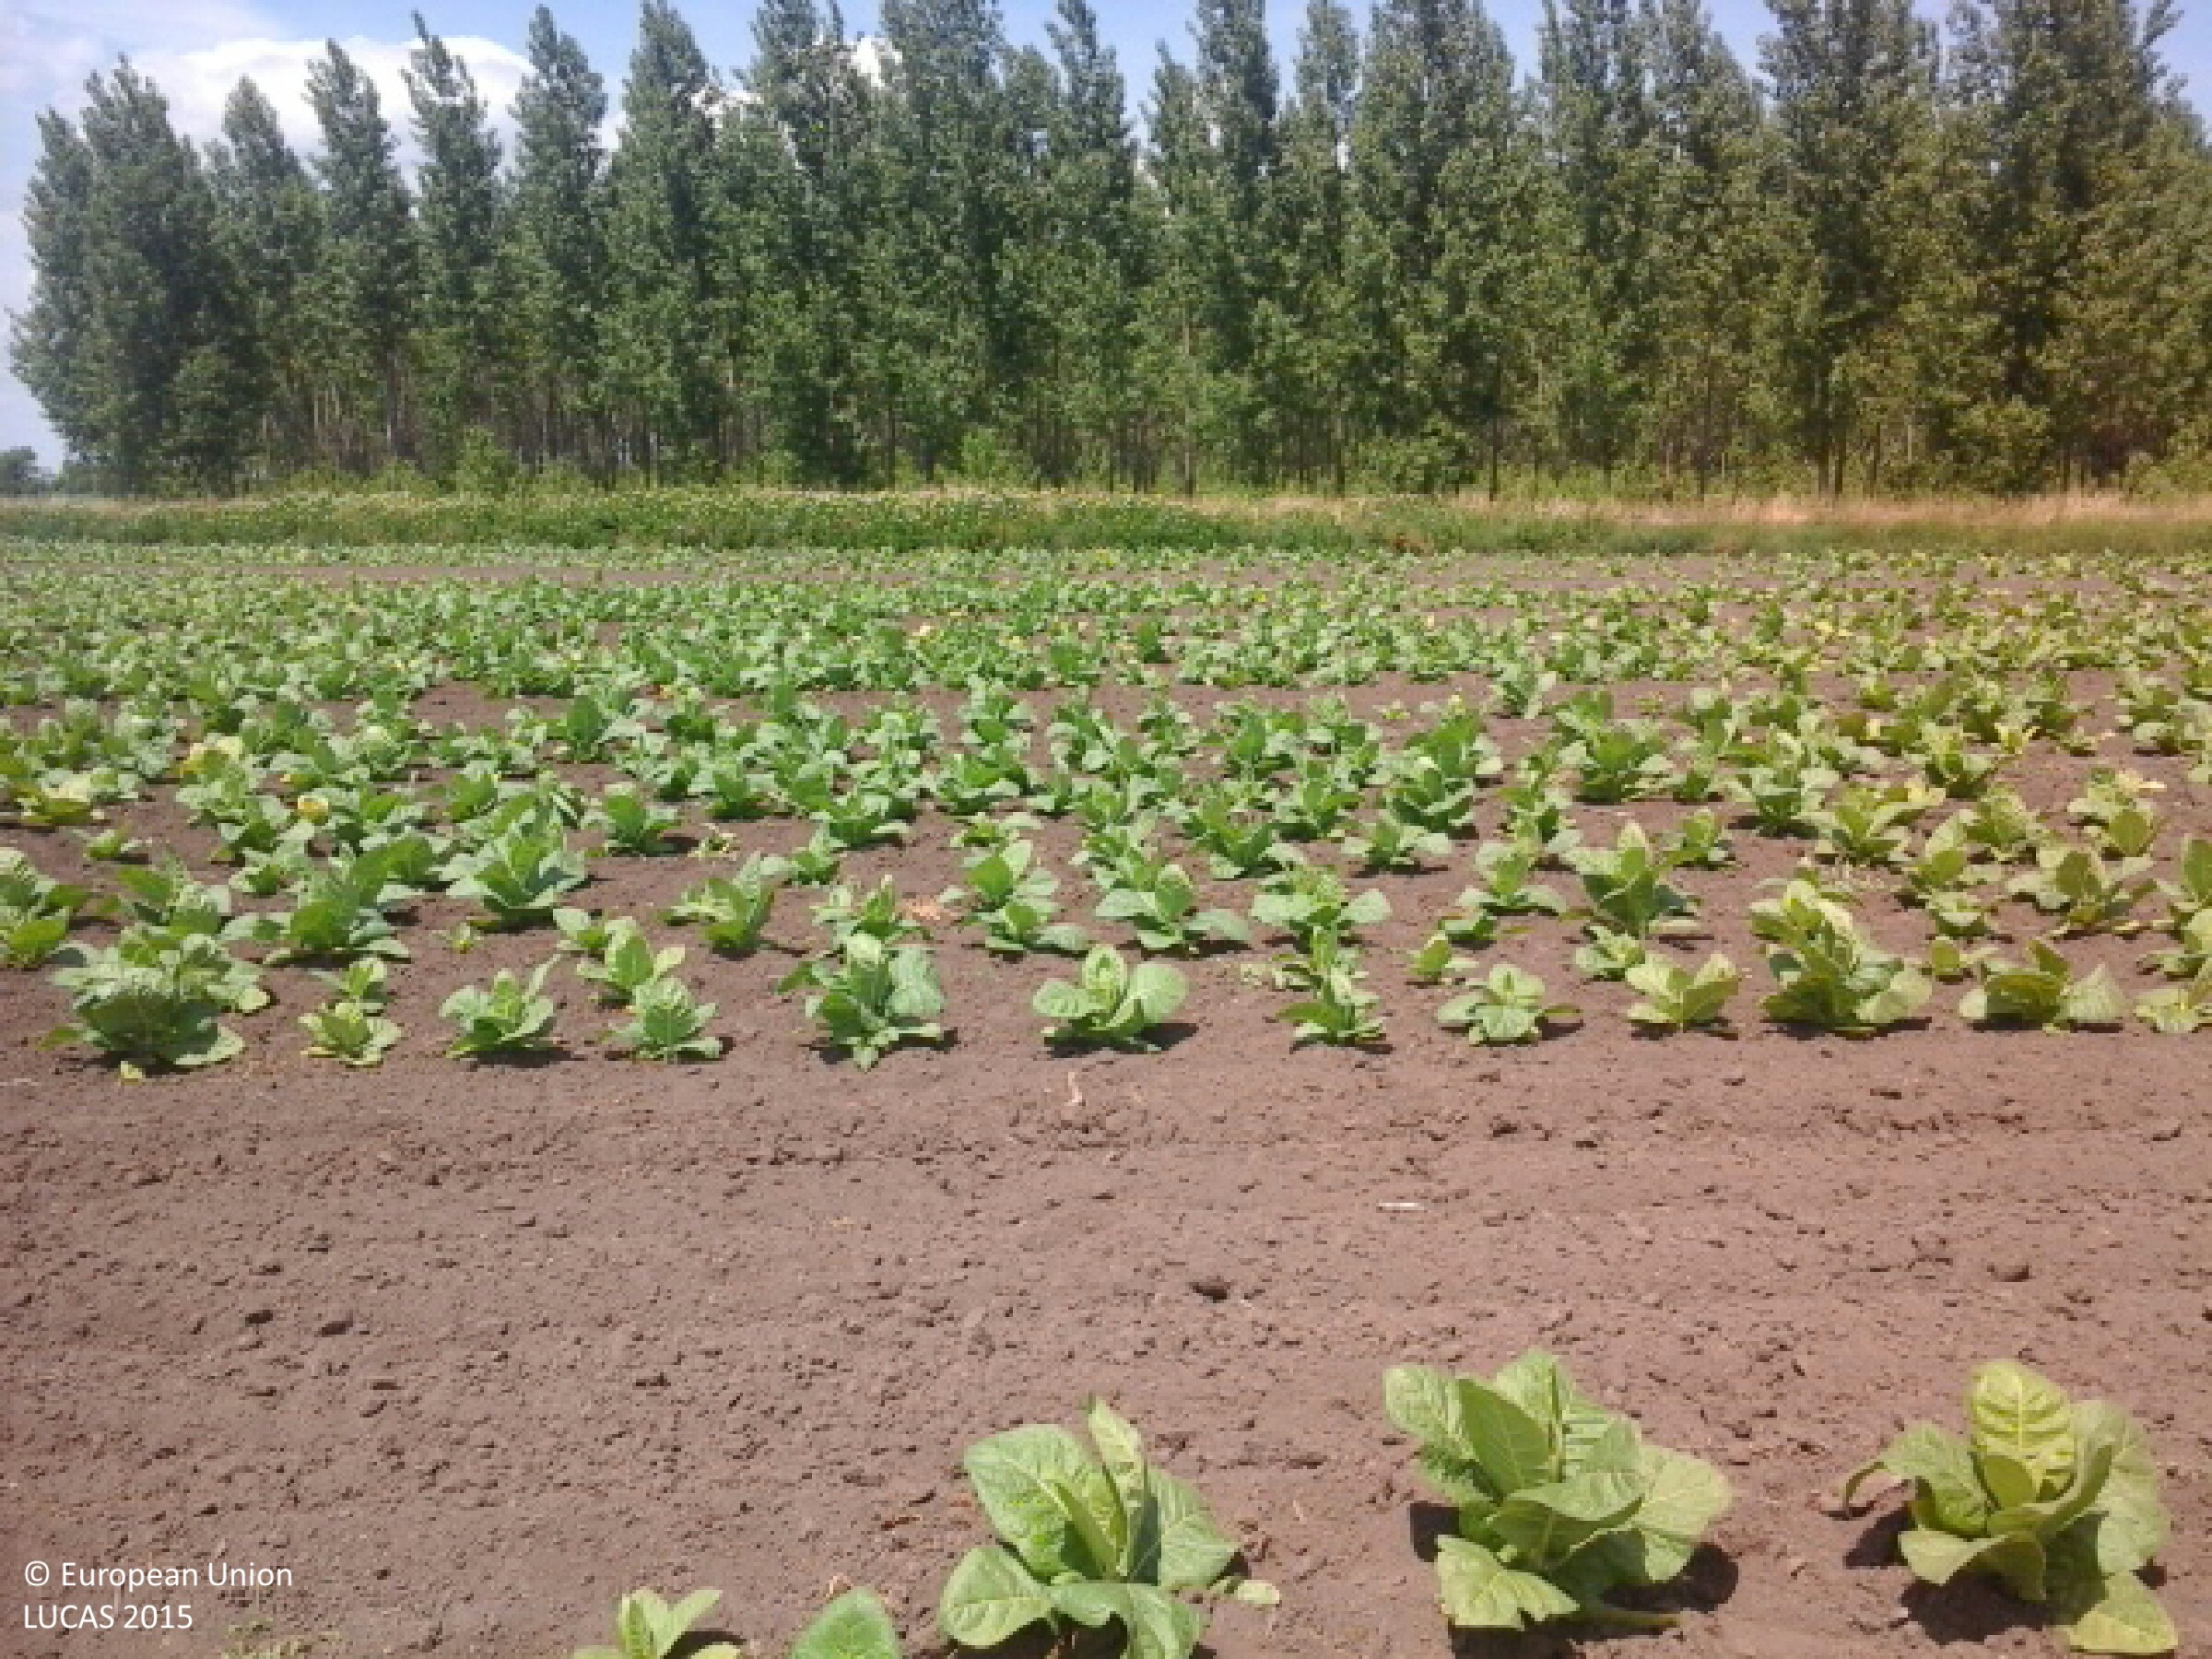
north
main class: Cropland
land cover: Tobacco
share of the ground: 10 - 25 %
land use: Agriculture (excluding fallow land and kitchen gardens)
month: June
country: HU
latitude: 47.9493
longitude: 21.9816
